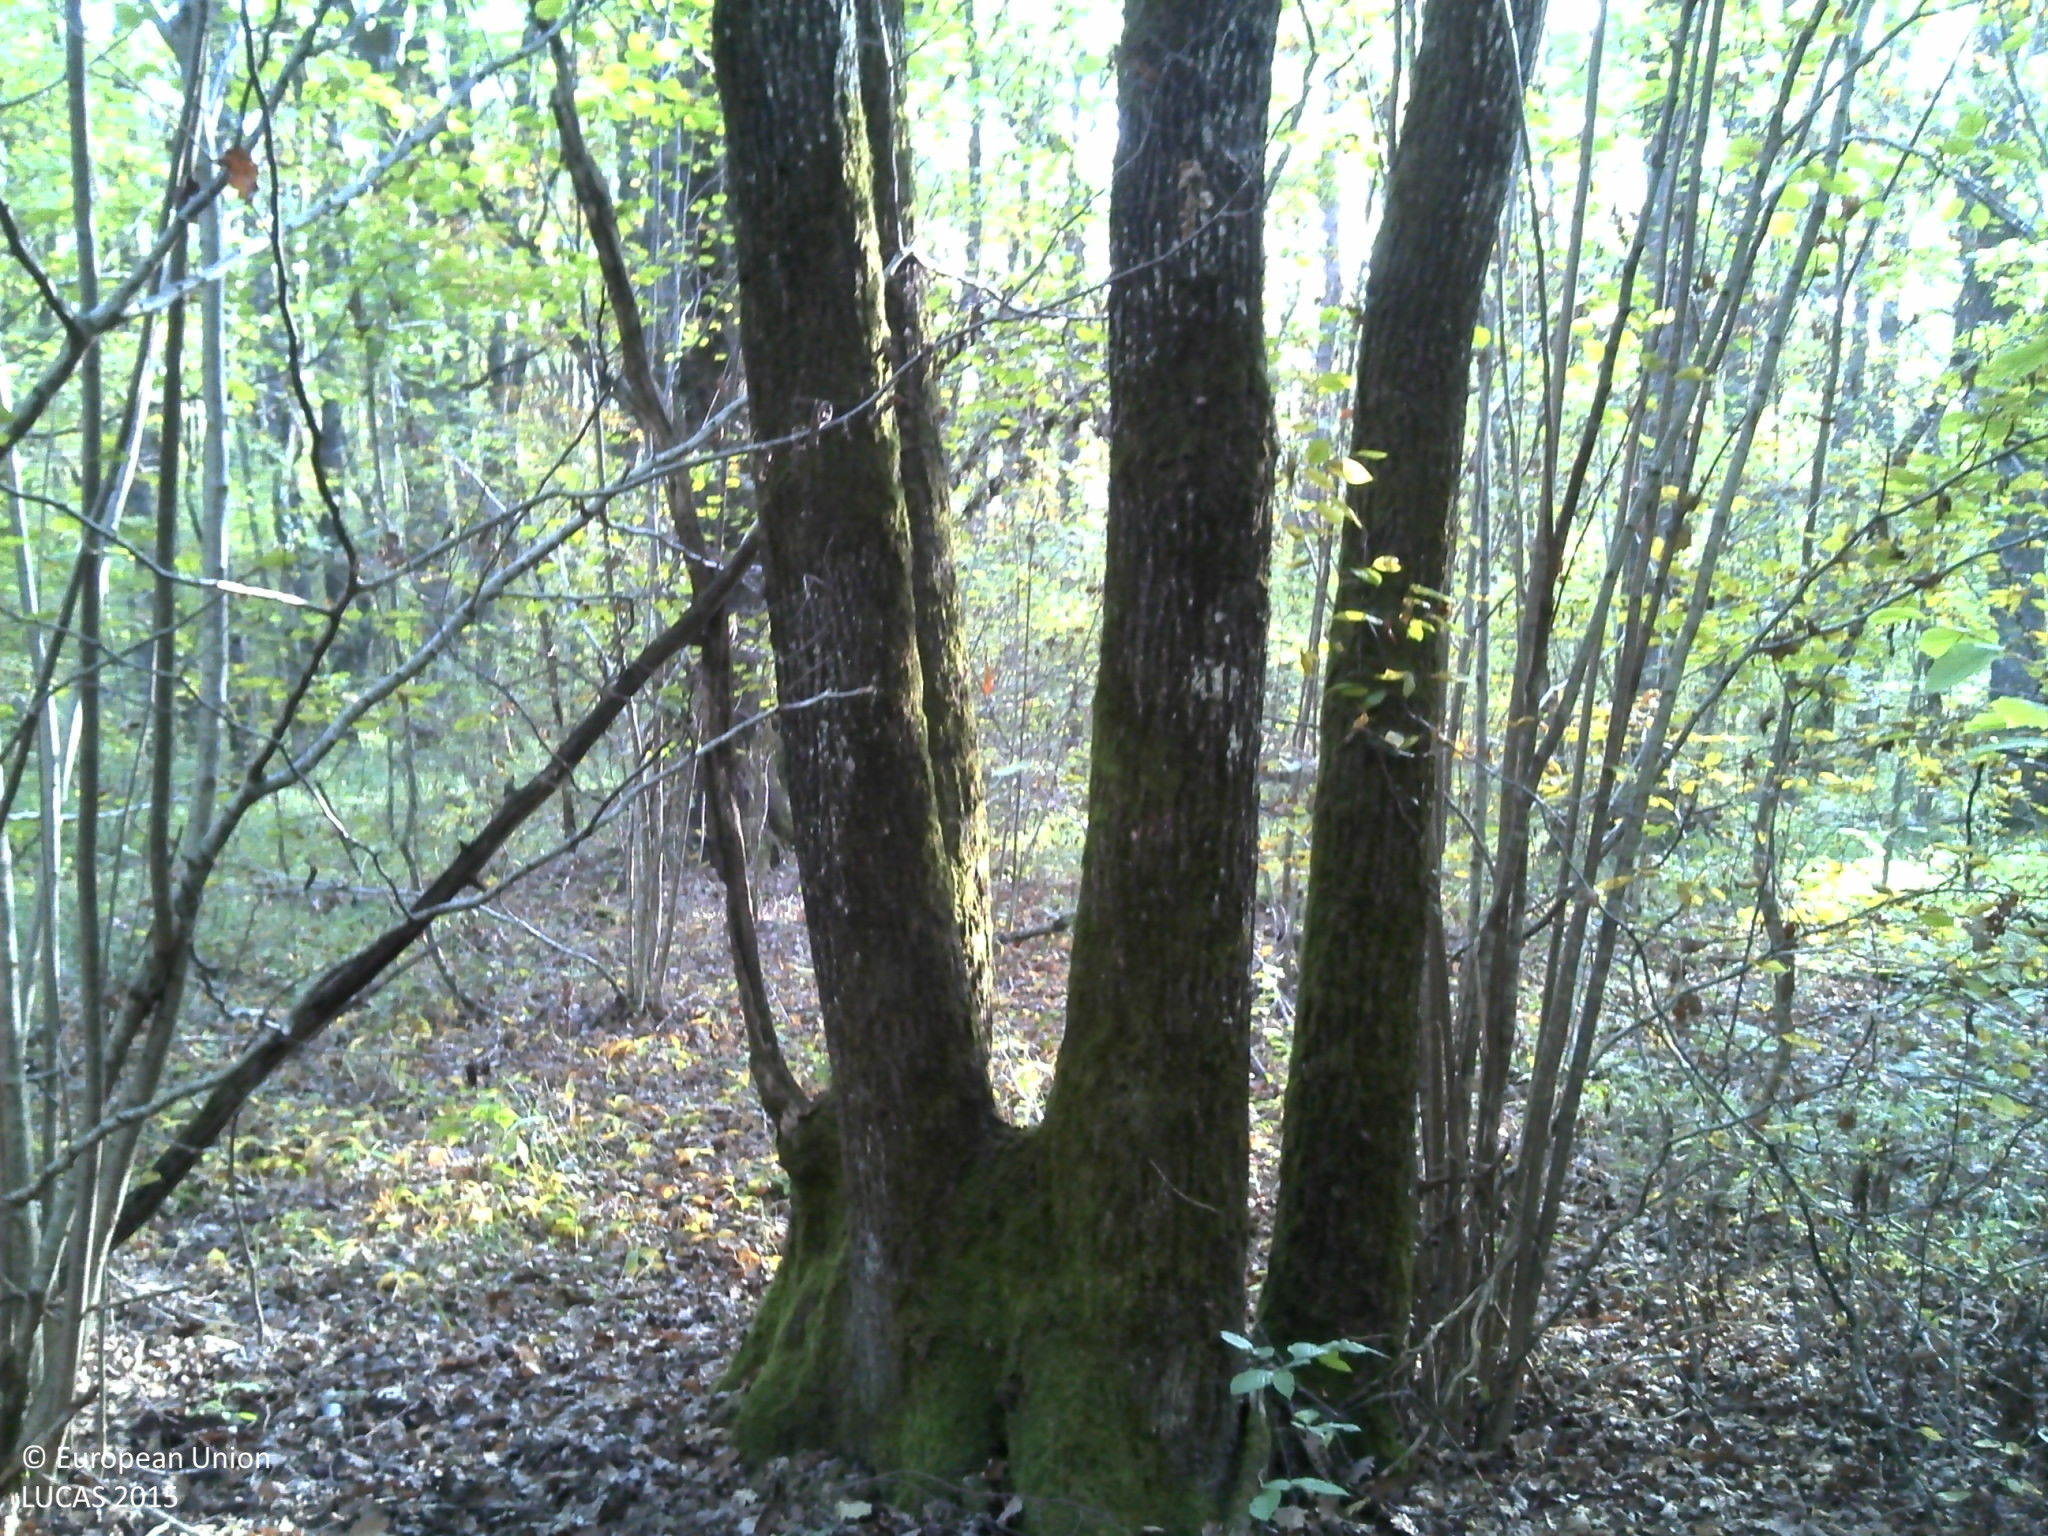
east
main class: Woodland
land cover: Broadleaved woodland
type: mesophytic deciduous forest
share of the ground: > 75 %
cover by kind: broadleaved forest trees 90 %, herbaceous plants 5 %, unconsolidated bare surface 5 %
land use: Forestry
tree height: > 5 m
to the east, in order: Broadleaved woodland; Tracks; Broadleaved woodland
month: October
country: FR
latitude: 46.2800
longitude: 6.0969
